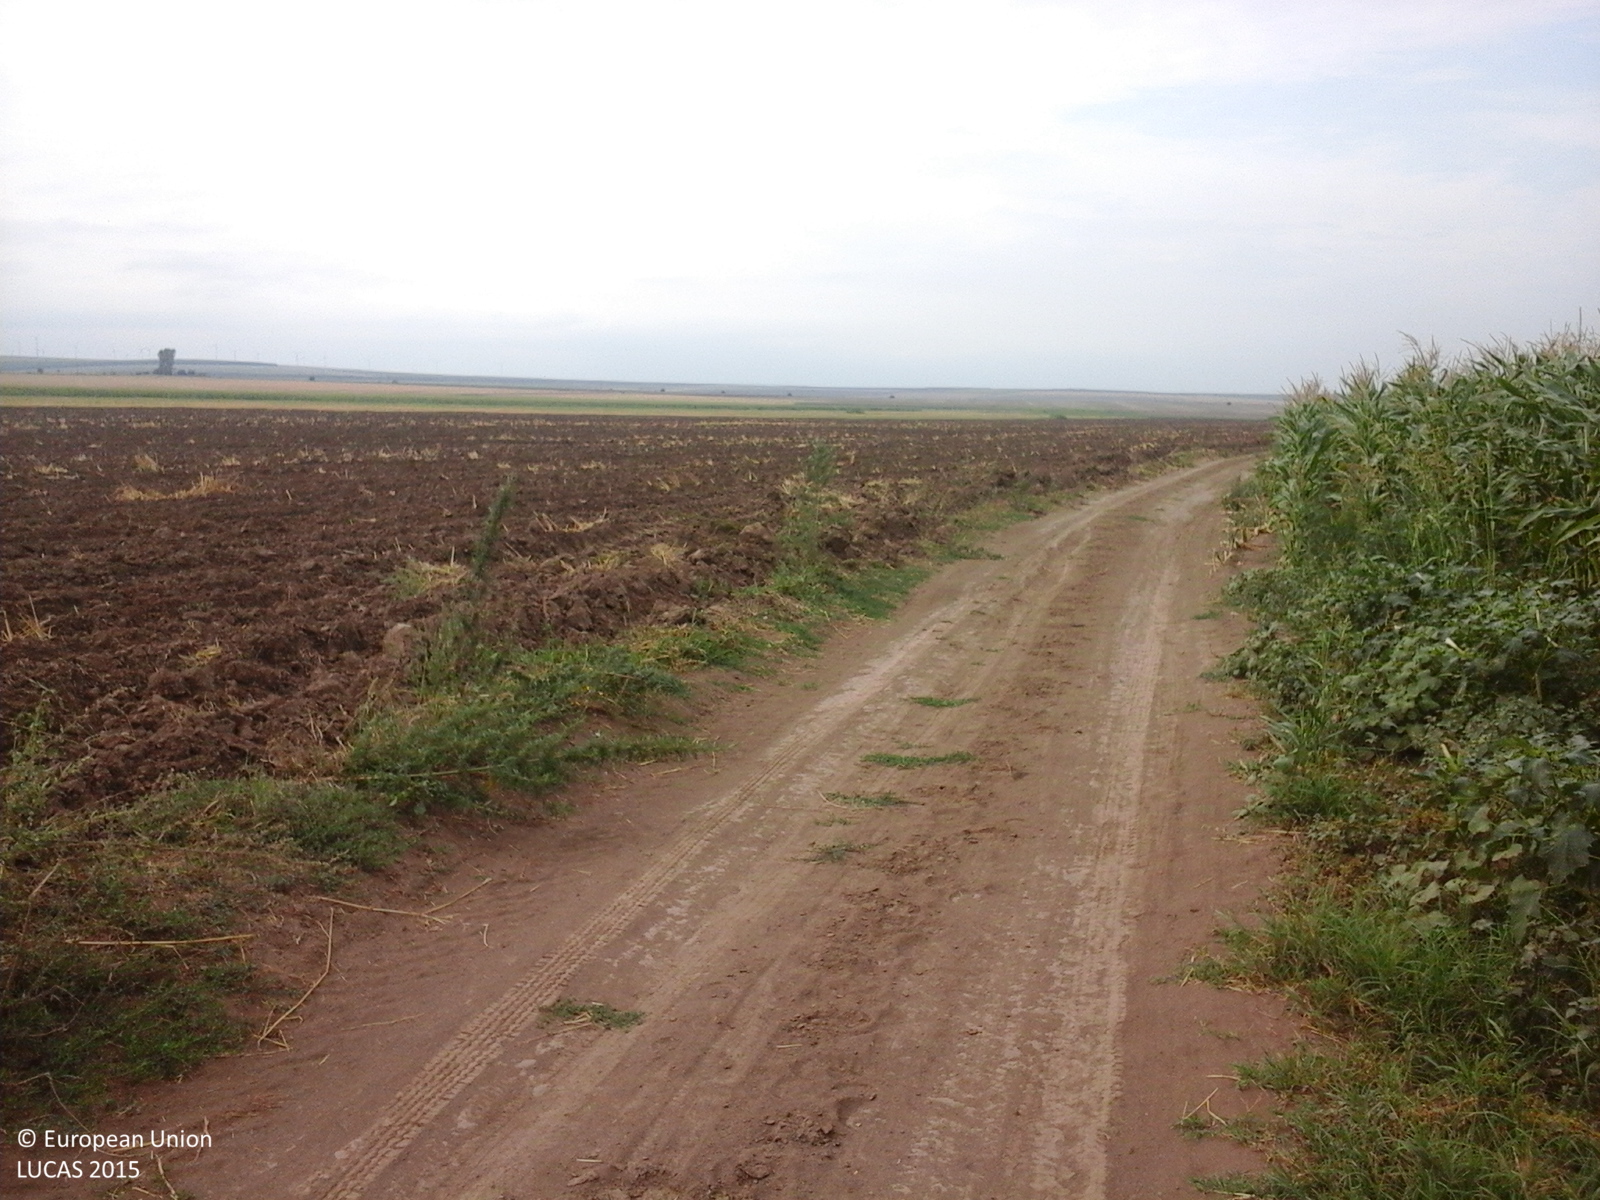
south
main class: Cropland
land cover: Maize
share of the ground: > 75 %
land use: Agriculture (excluding fallow land and kitchen gardens)
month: August
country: RO
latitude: 44.8686
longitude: 28.1786
